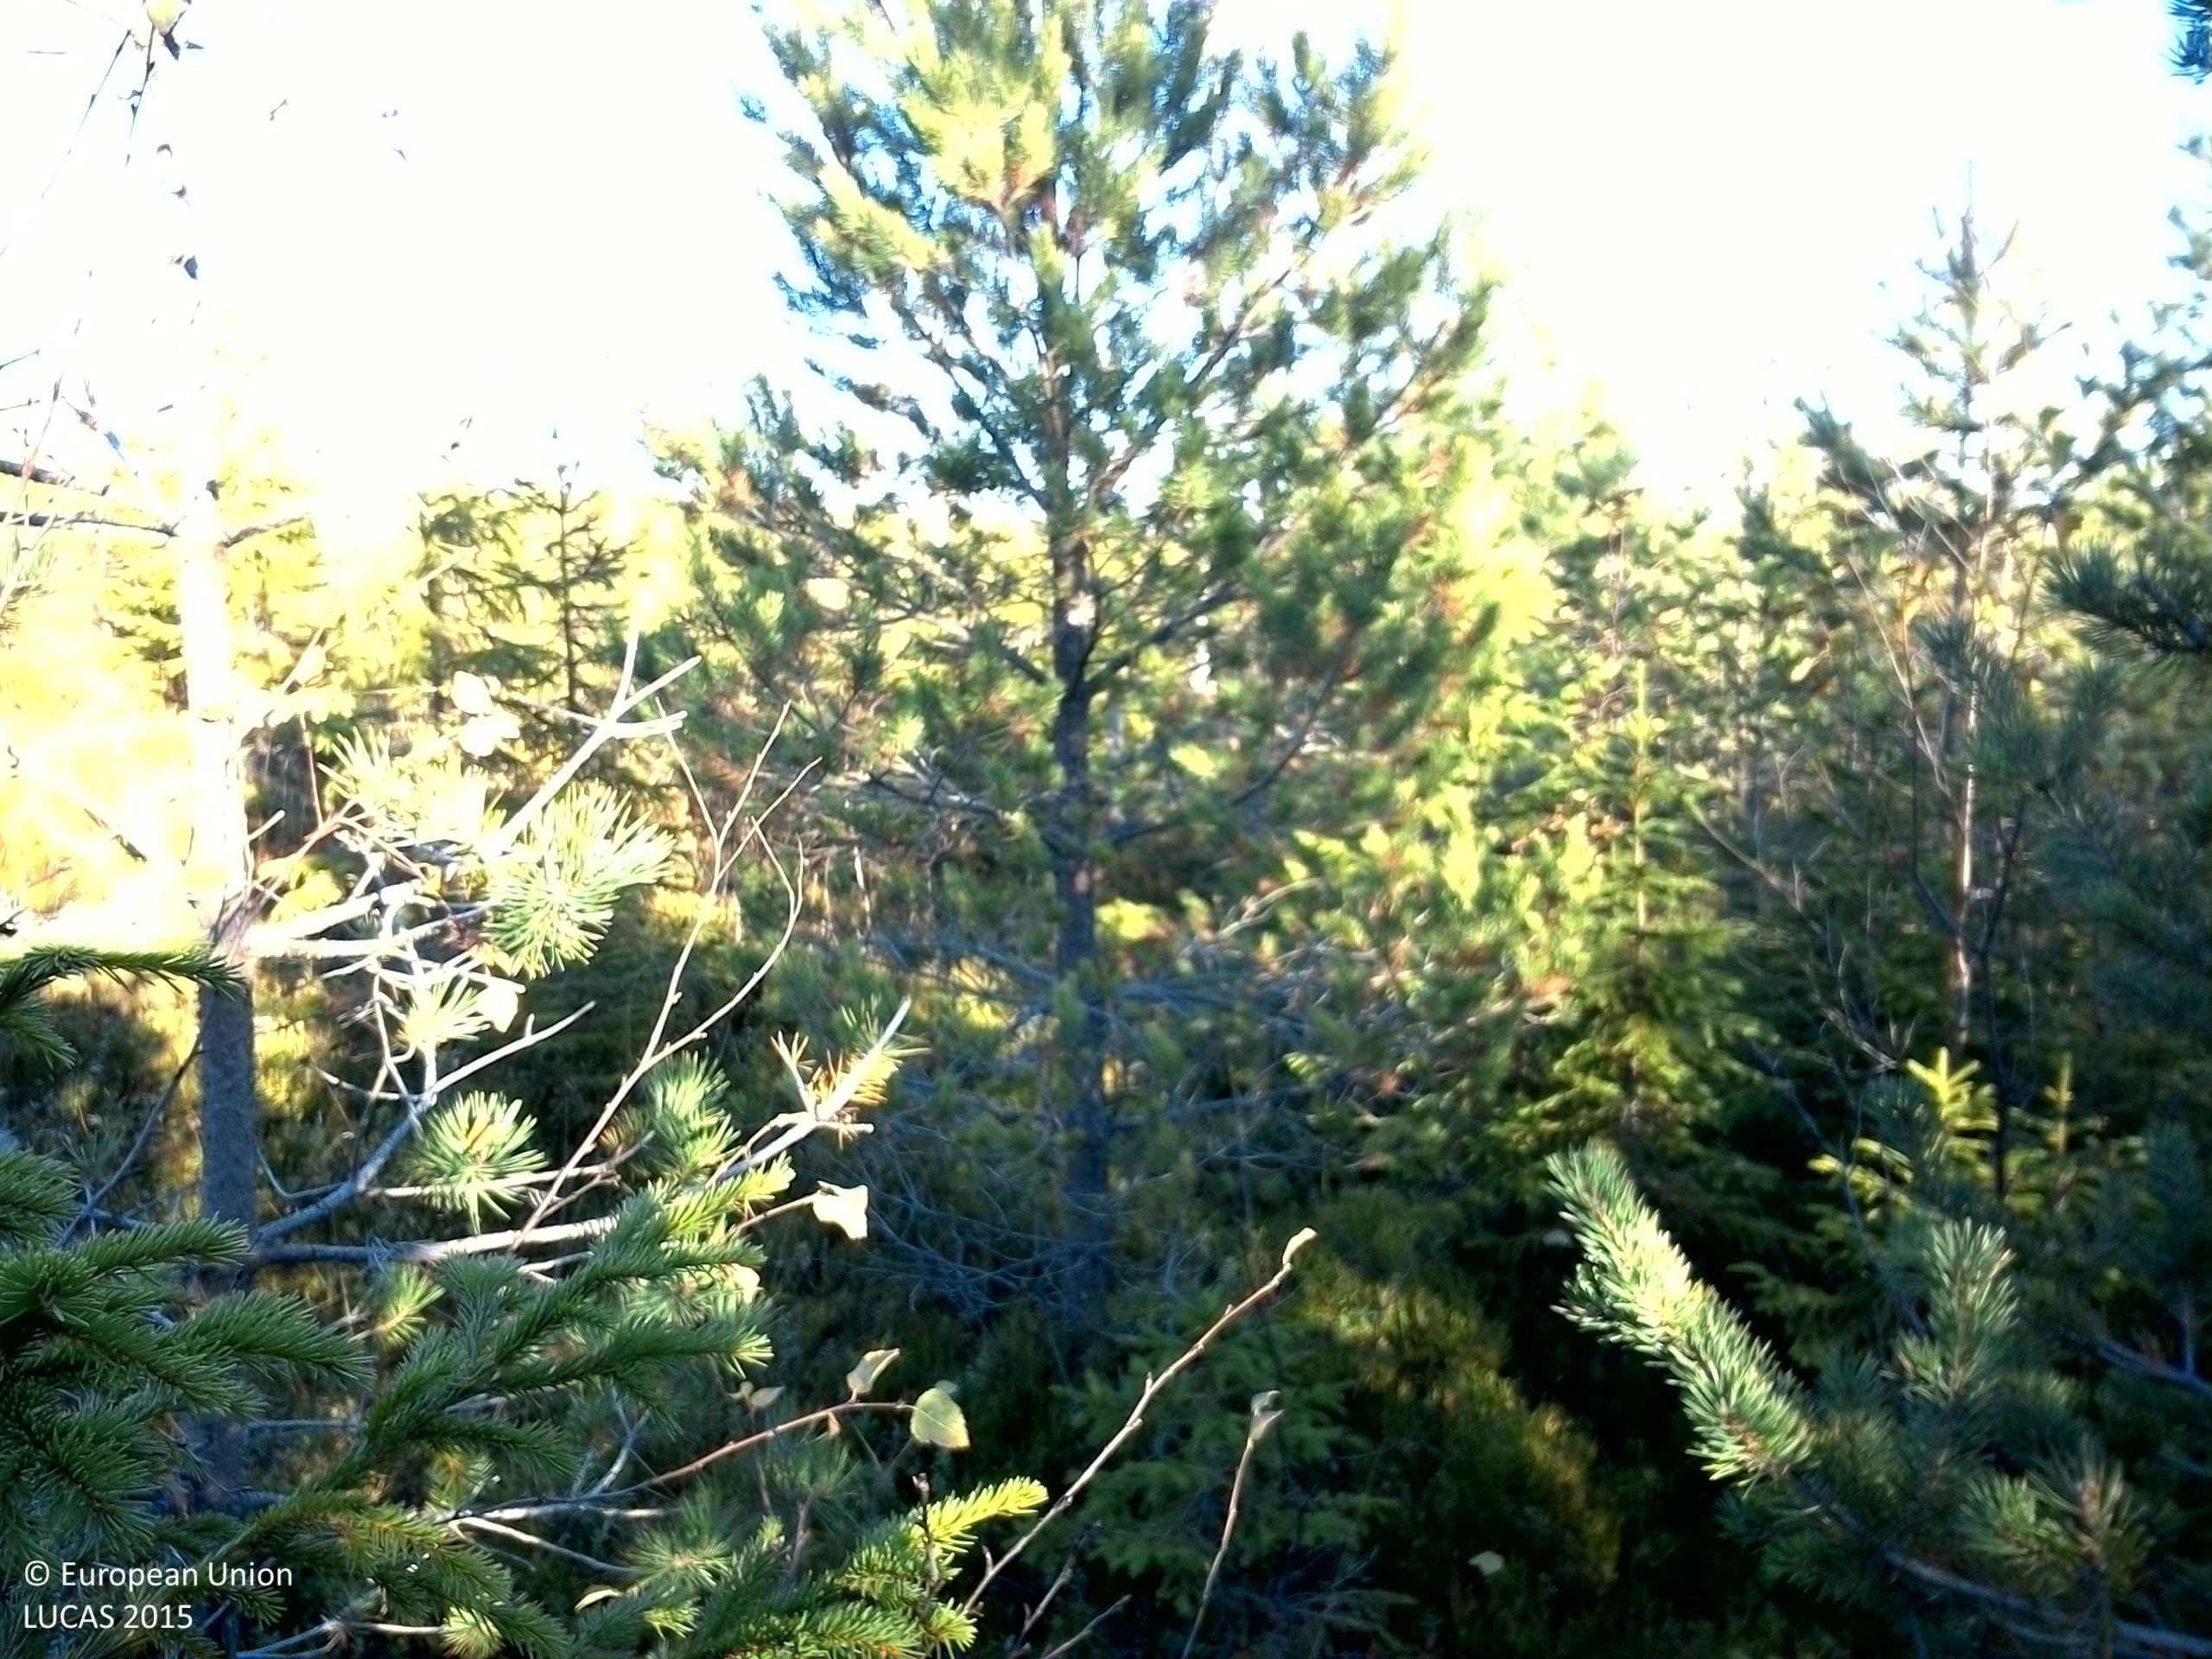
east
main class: Woodland
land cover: Other coniferous woodland
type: boreal forest
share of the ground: 50 - 75 %
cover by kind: coniferous forest trees 60 %, shrubs 25 %, lichens and mosses 10 %, broadleaved forest trees 5 %
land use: Forestry
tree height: < 5 m
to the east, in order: Other coniferous woodland; Spruce dominated mixed woodland; Other mixed woodland; Spruce dominated mixed woodland
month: October
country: SE
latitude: 61.3060
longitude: 14.8583
